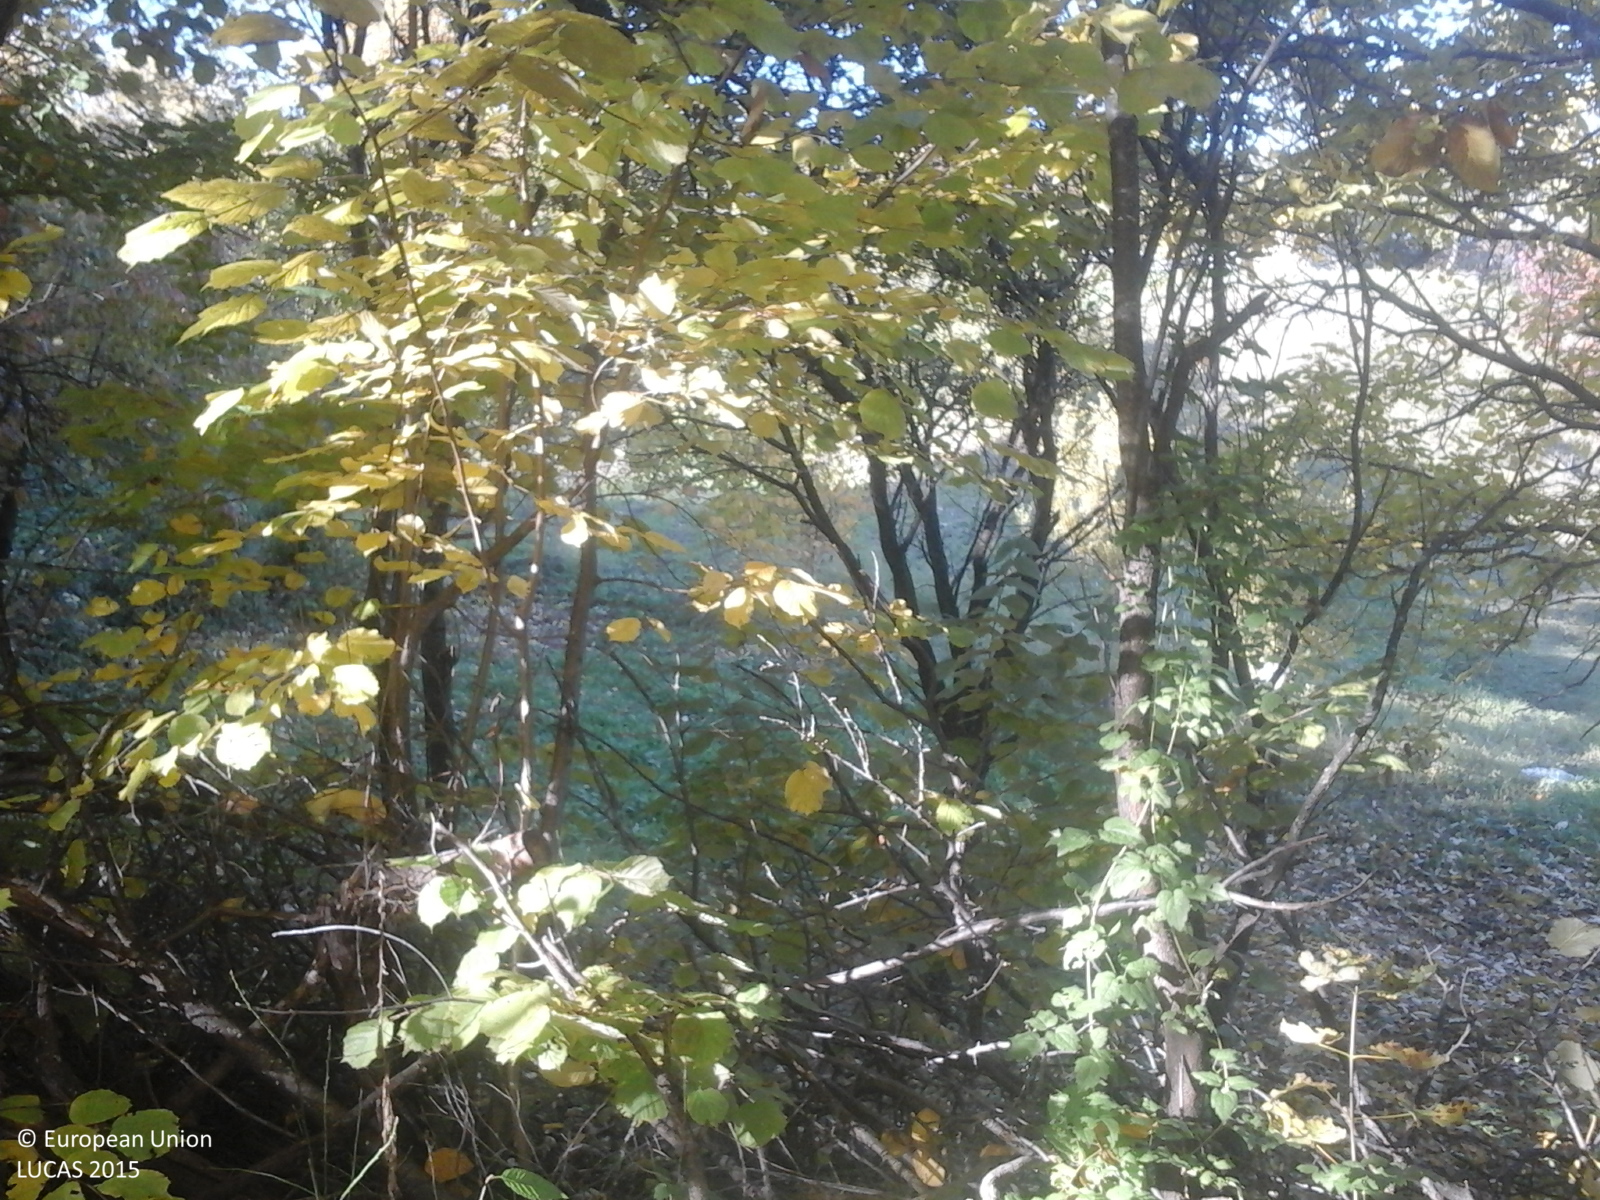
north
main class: Woodland
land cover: Broadleaved woodland
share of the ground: > 75 %
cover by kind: broadleaved forest trees 100 %
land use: Forestry
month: October
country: RO
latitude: 45.8601
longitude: 26.6580
